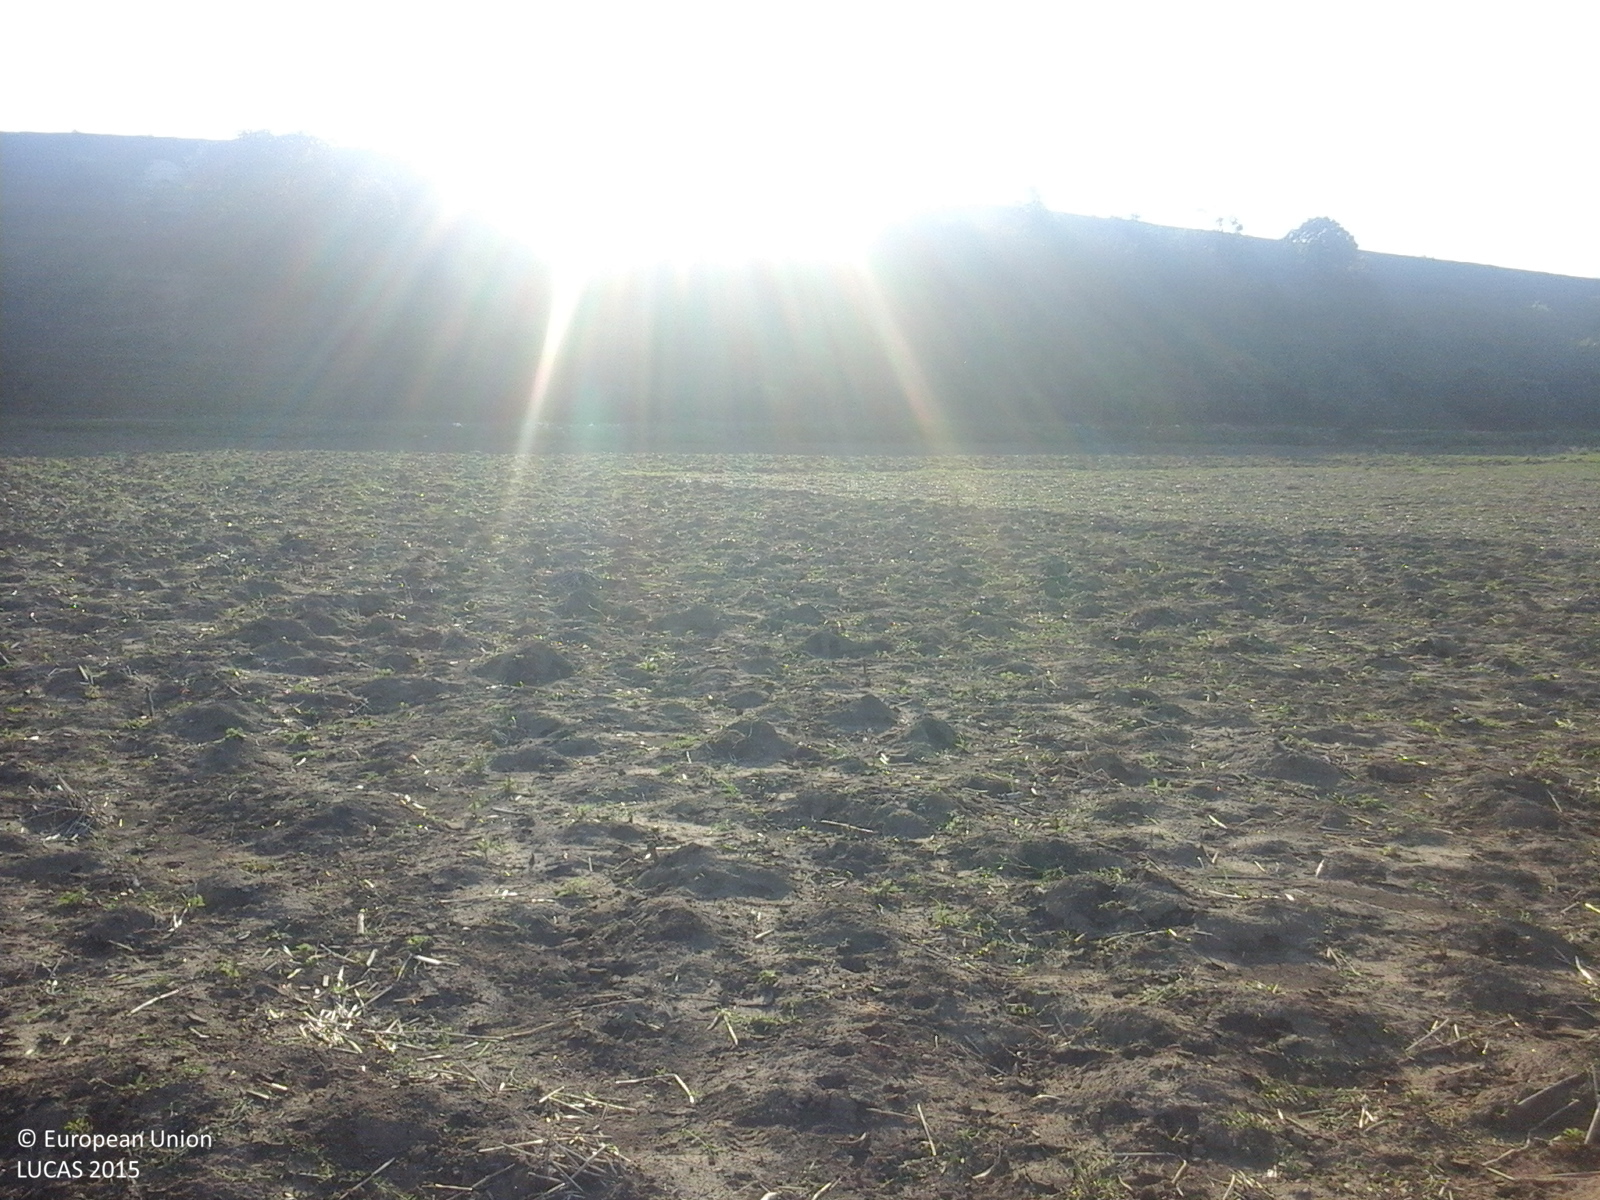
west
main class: Cropland
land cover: Common wheat
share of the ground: < 10 %
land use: Agriculture (excluding fallow land and kitchen gardens)
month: August
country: RO
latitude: 46.3173
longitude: 27.0169
